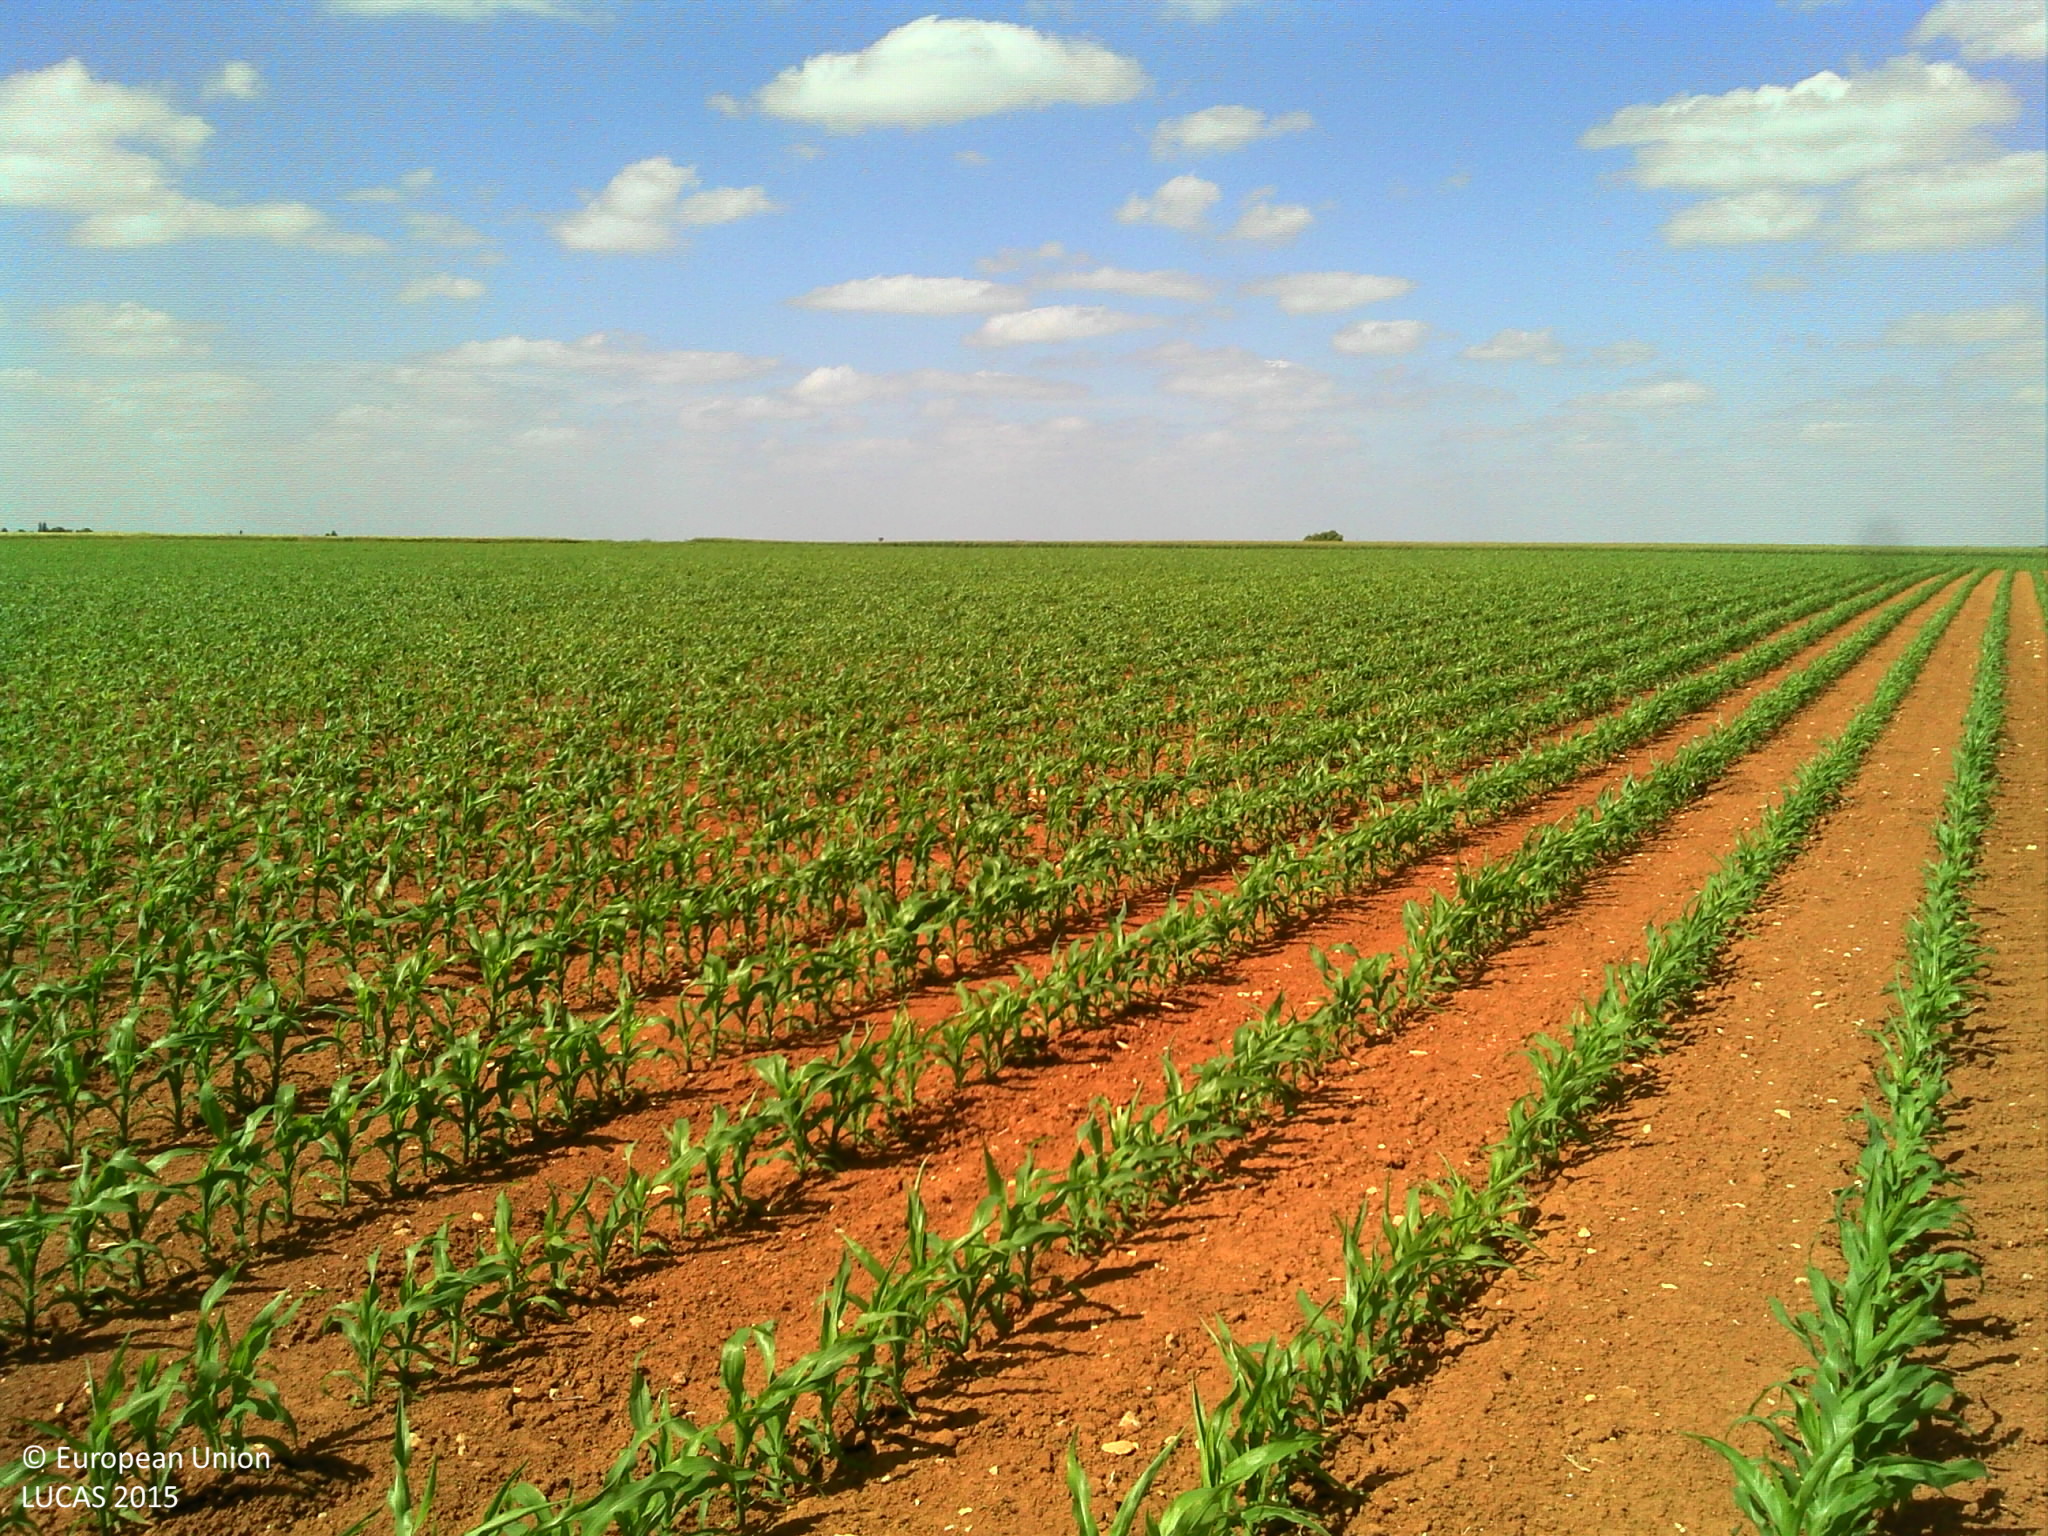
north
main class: Cropland
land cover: Maize
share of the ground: 25 - 50 %
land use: Agriculture (excluding fallow land and kitchen gardens)
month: June
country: FR
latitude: 48.0570
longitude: 1.4911
